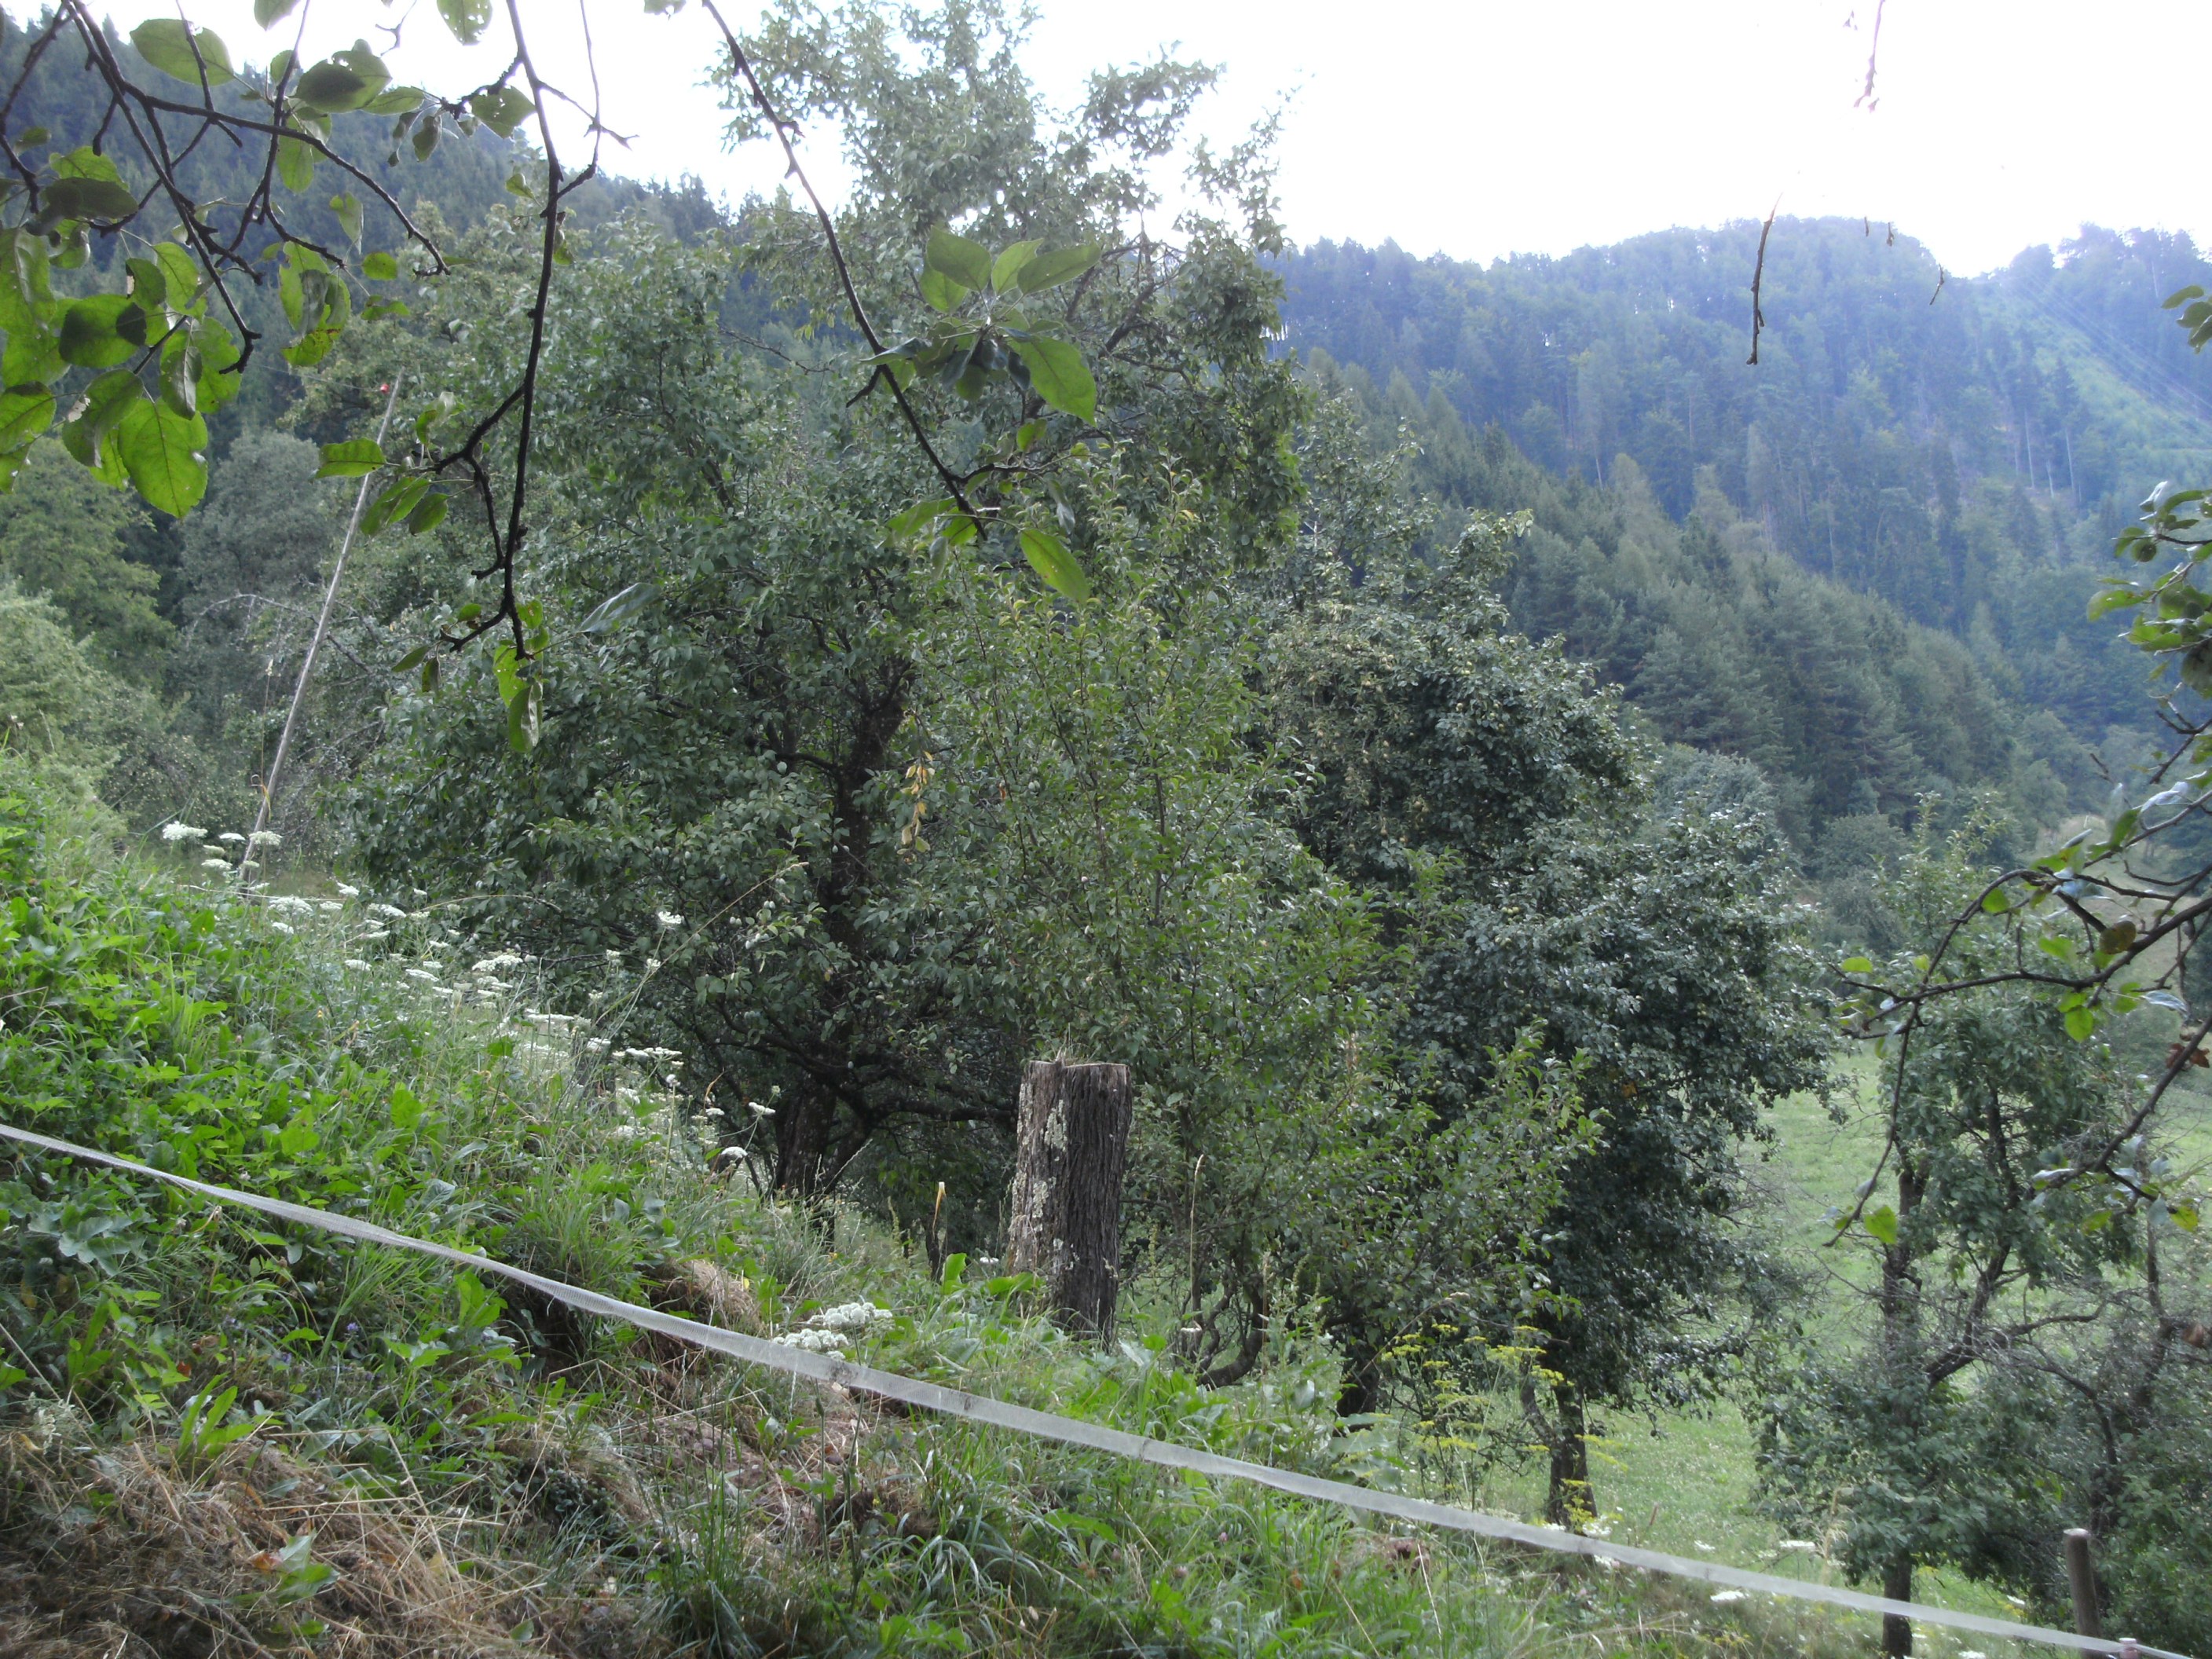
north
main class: Cropland
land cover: Apple fruit
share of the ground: > 75 %
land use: Agriculture (excluding fallow land and kitchen gardens)
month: July
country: AT
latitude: 46.6731
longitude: 14.8739
